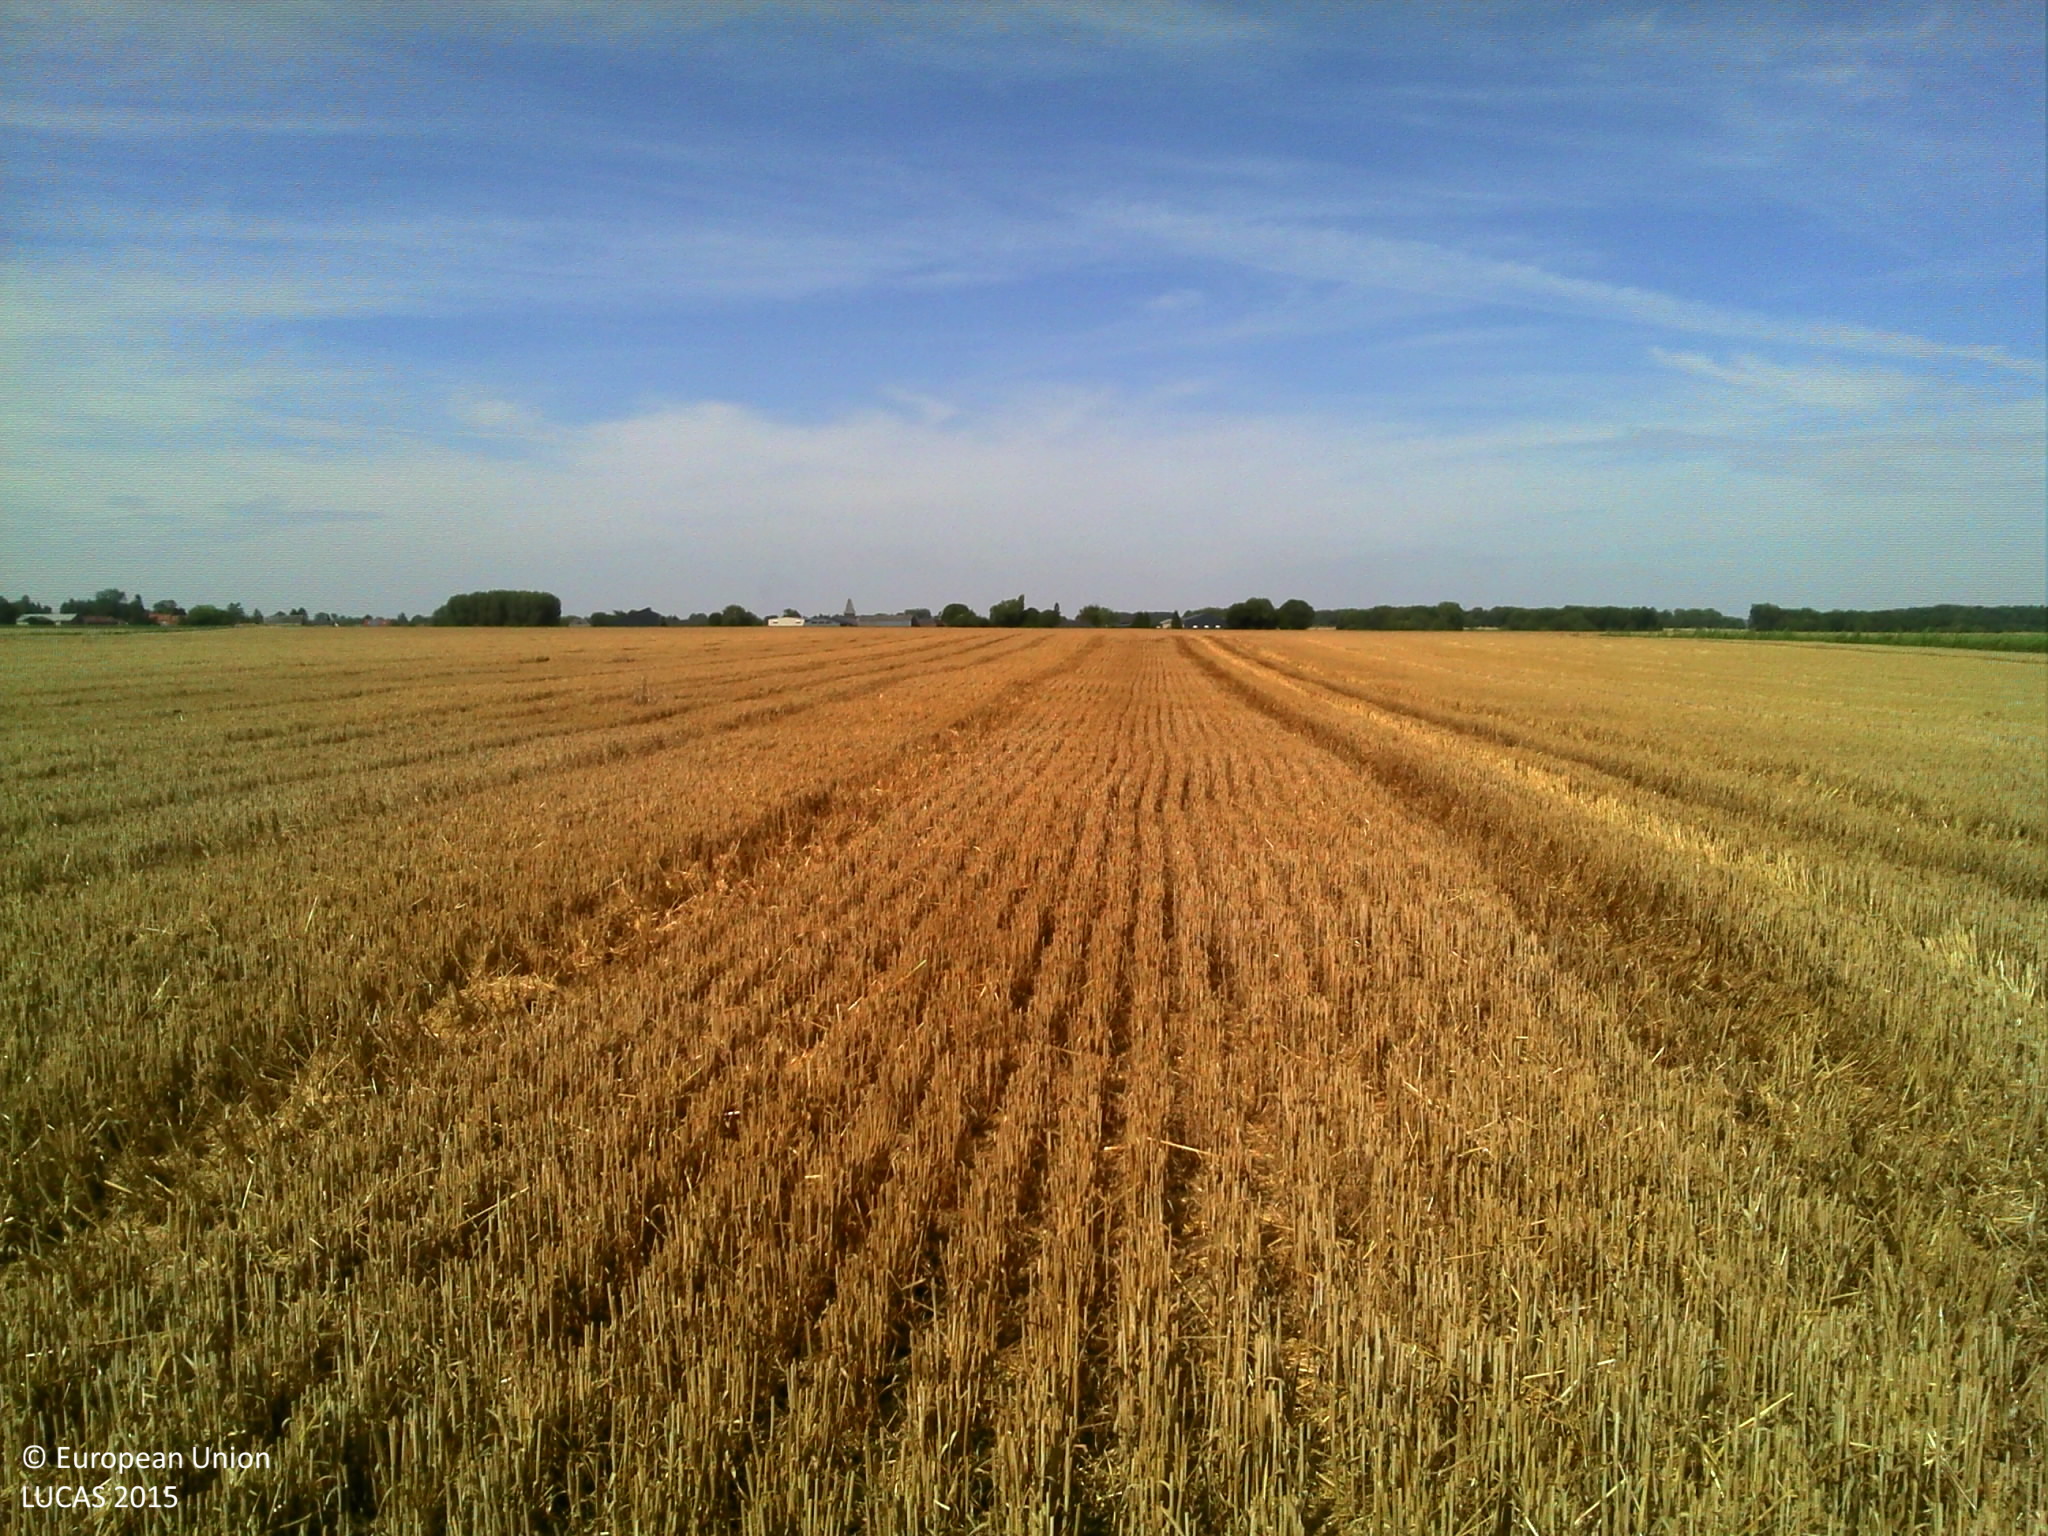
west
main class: Cropland
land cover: Common wheat
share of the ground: > 75 %
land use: Agriculture (excluding fallow land and kitchen gardens)
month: August
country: FR
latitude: 49.8642
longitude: 2.7689
